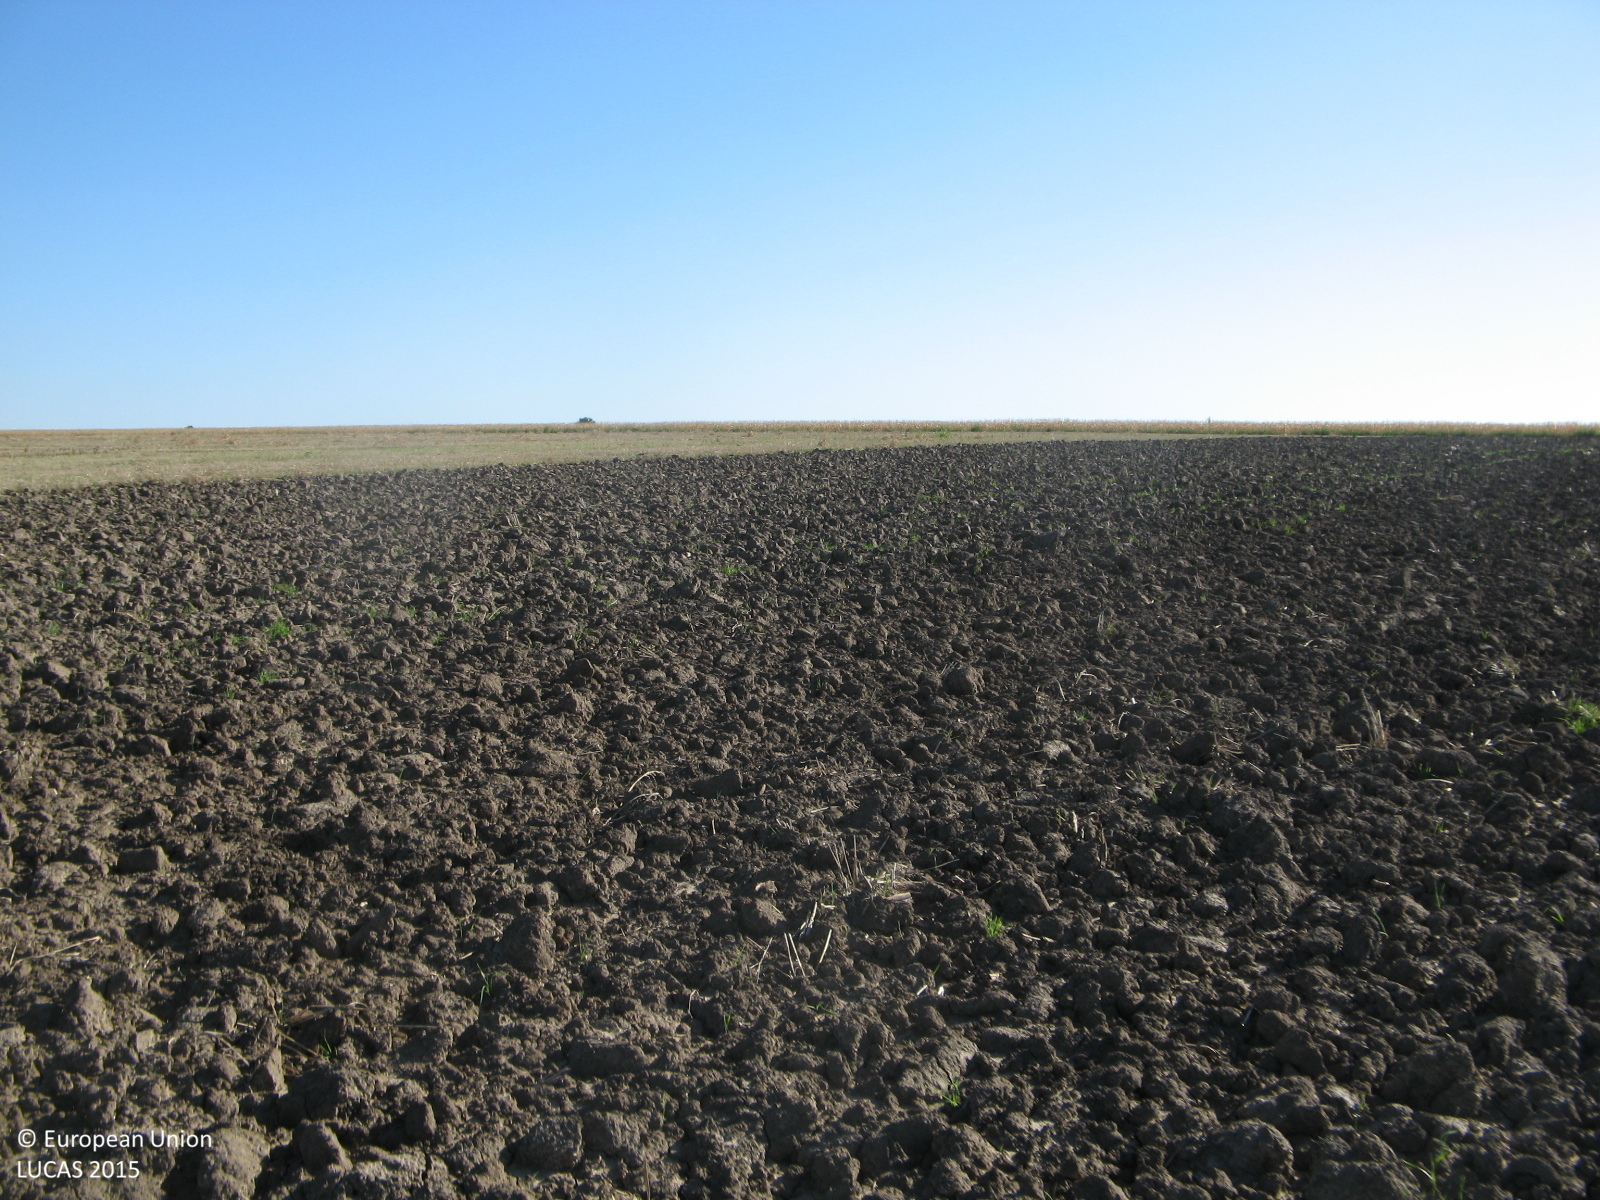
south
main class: Cropland
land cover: Common wheat
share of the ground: < 10 %
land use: Agriculture (excluding fallow land and kitchen gardens)
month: September
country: BG
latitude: 43.7049
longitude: 26.1184
